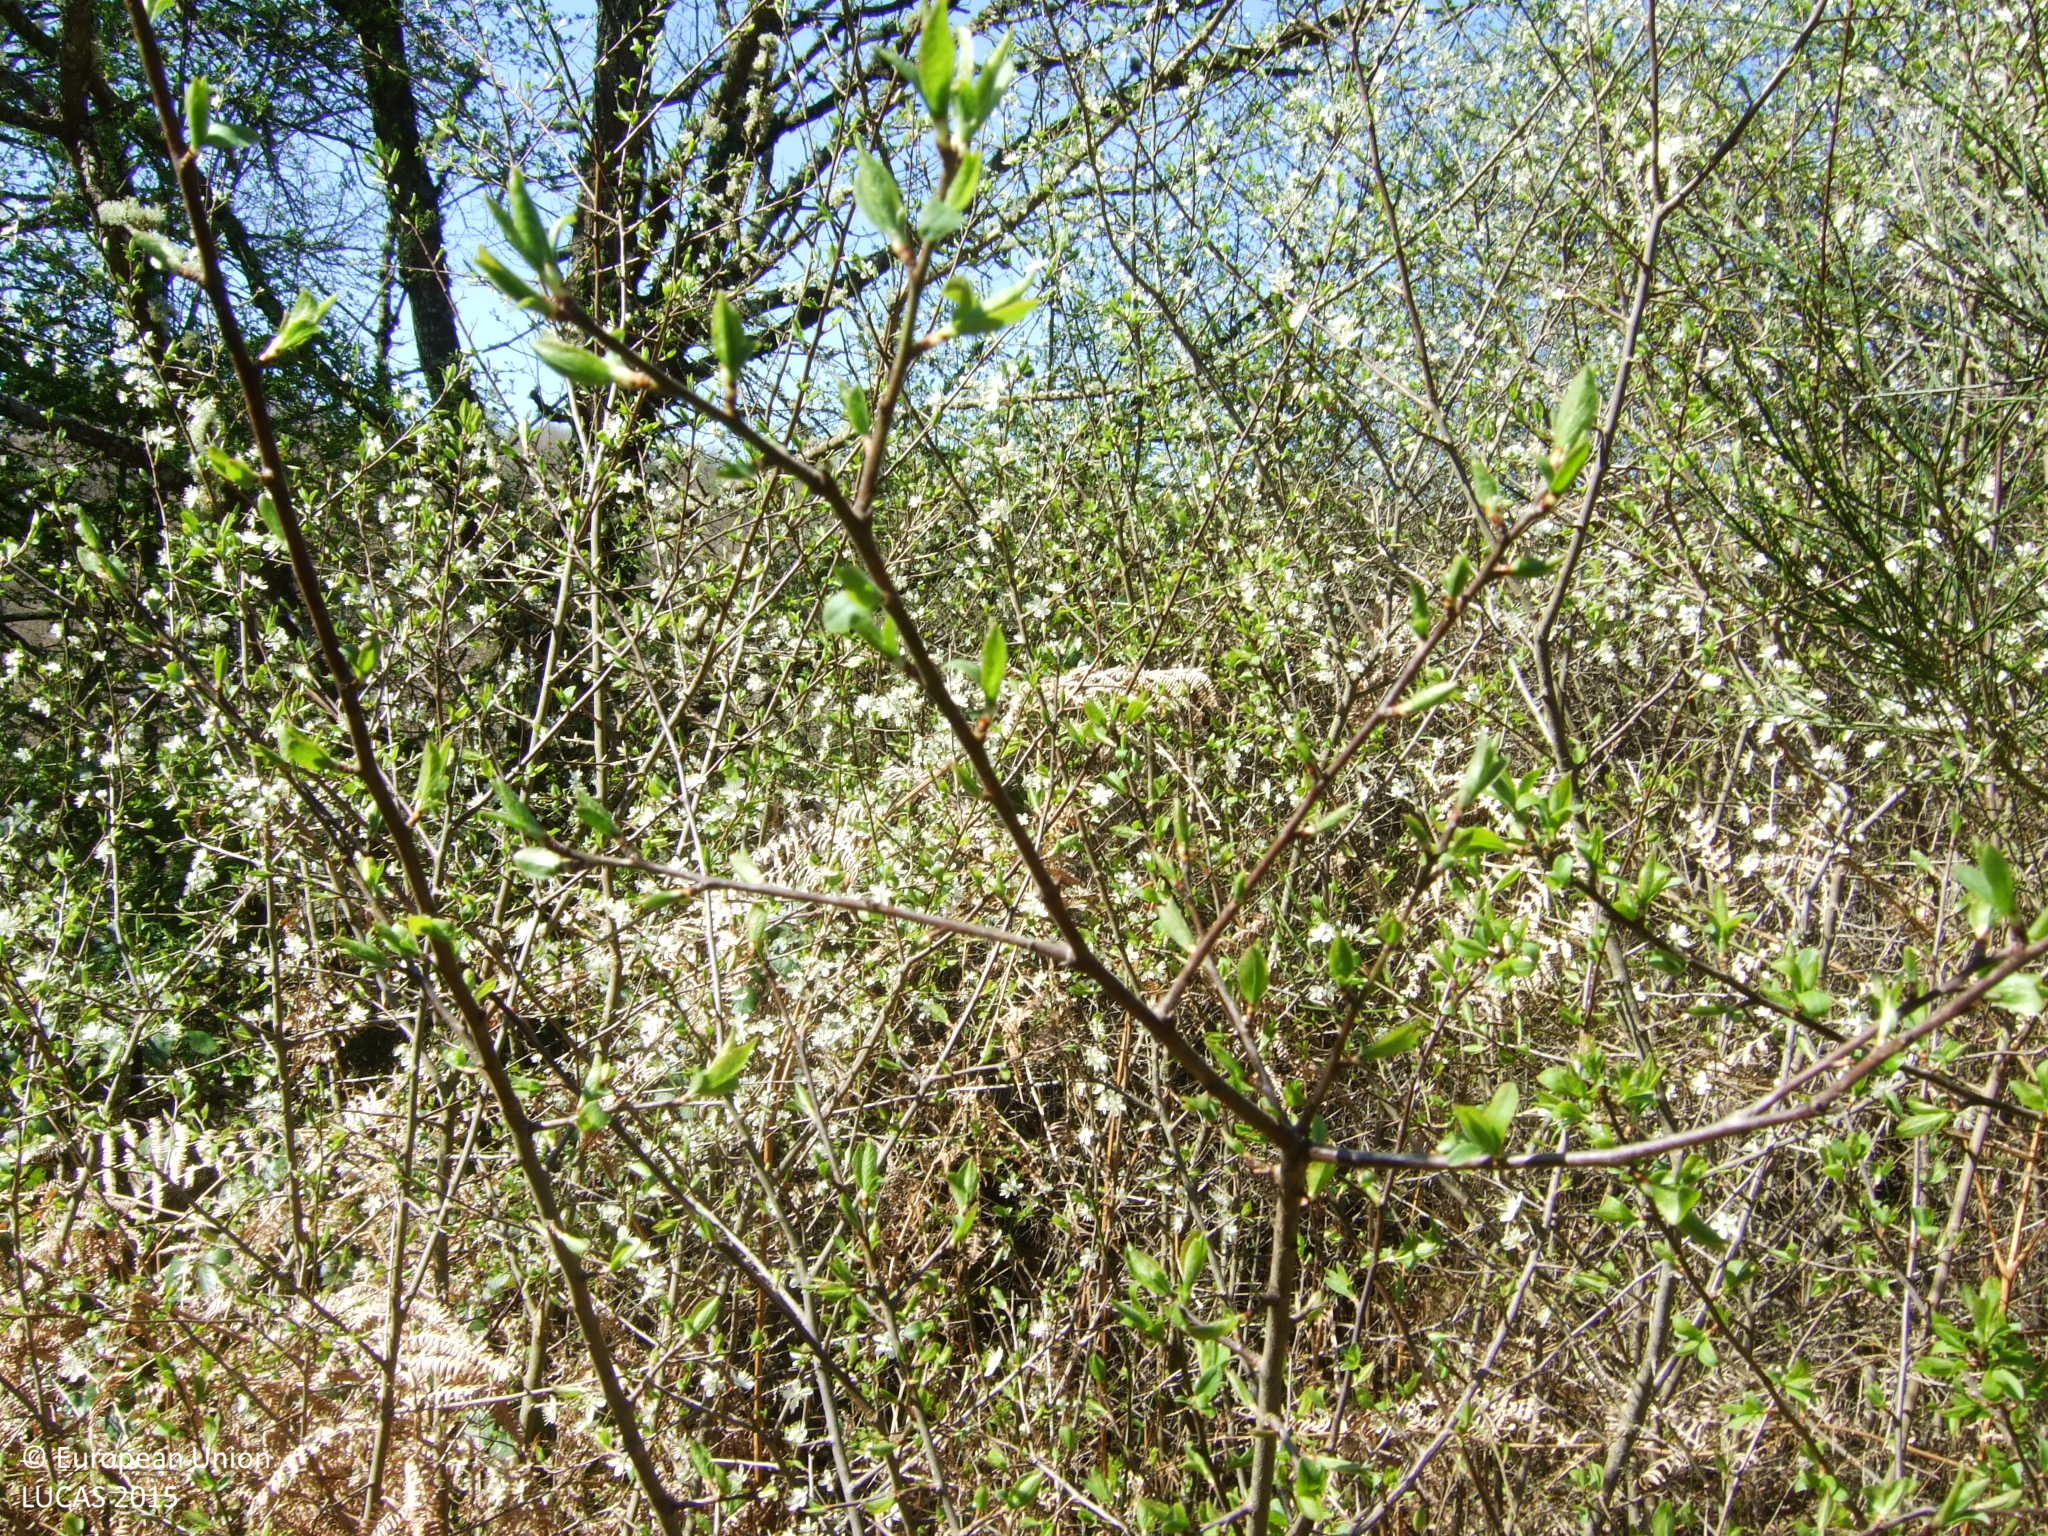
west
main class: Shrubland
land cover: Shrubland with sparse tree cover
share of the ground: > 75 %
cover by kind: shrubs 75 %, herbaceous plants 20 %, broadleaved forest trees 5 %
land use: Semi-natural and natural areas not in use
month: April
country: ES
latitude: 42.7050
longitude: -7.7946
